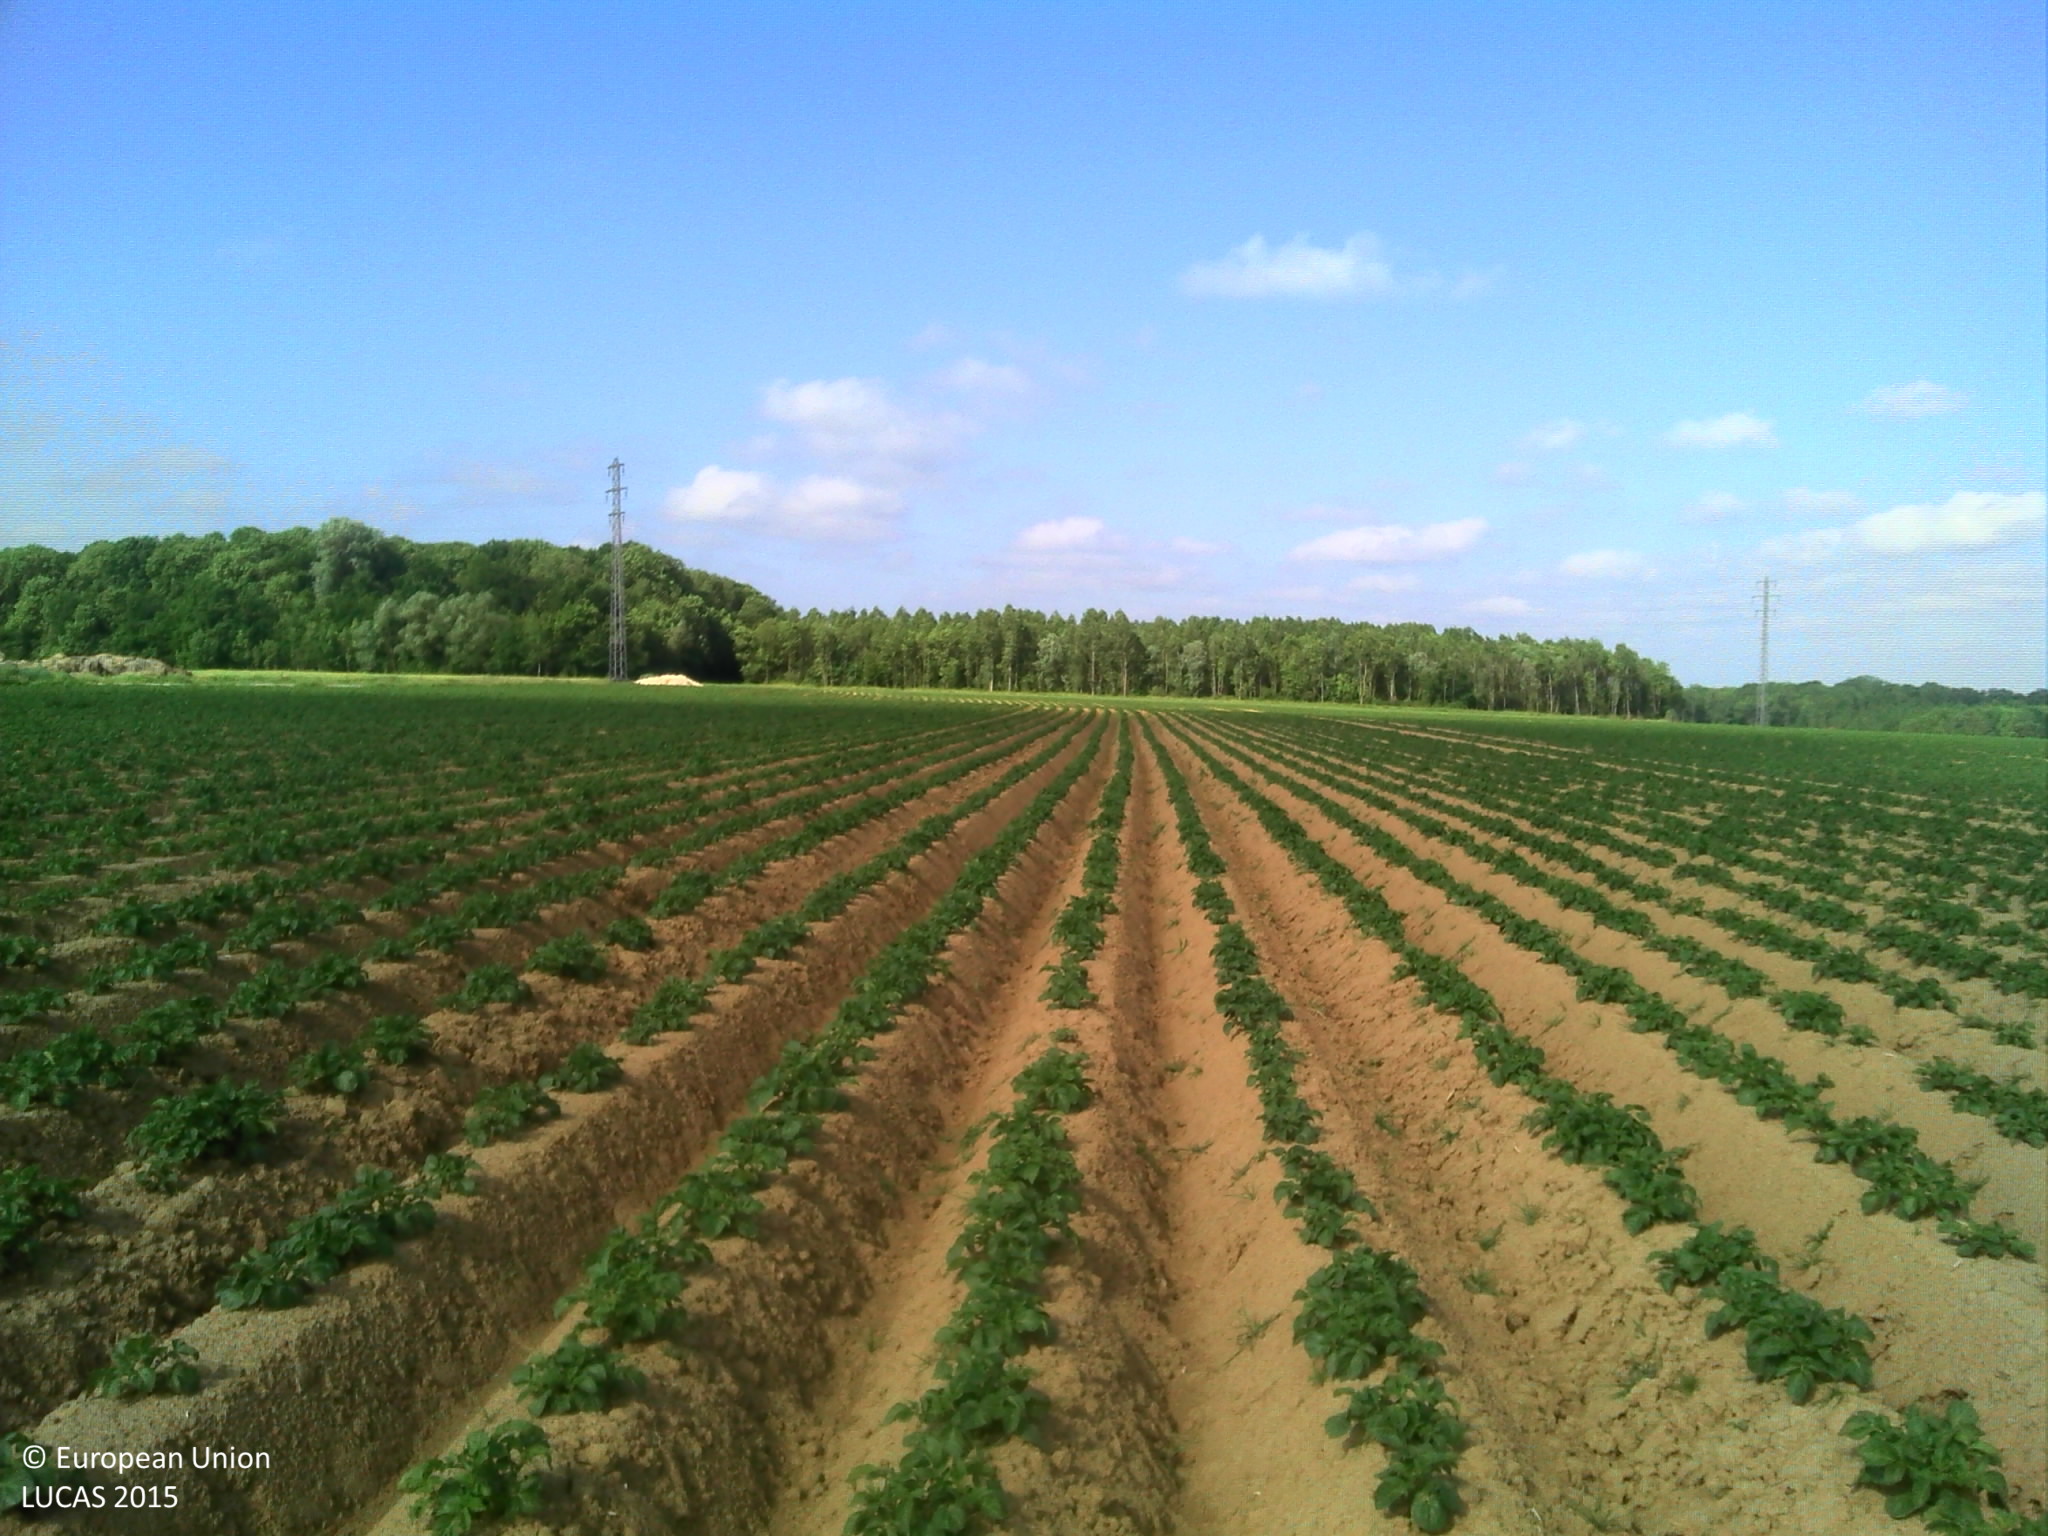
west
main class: Cropland
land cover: Potatoes
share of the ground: 10 - 25 %
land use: Agriculture (excluding fallow land and kitchen gardens)
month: June
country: BE
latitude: 50.4044
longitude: 4.7203
